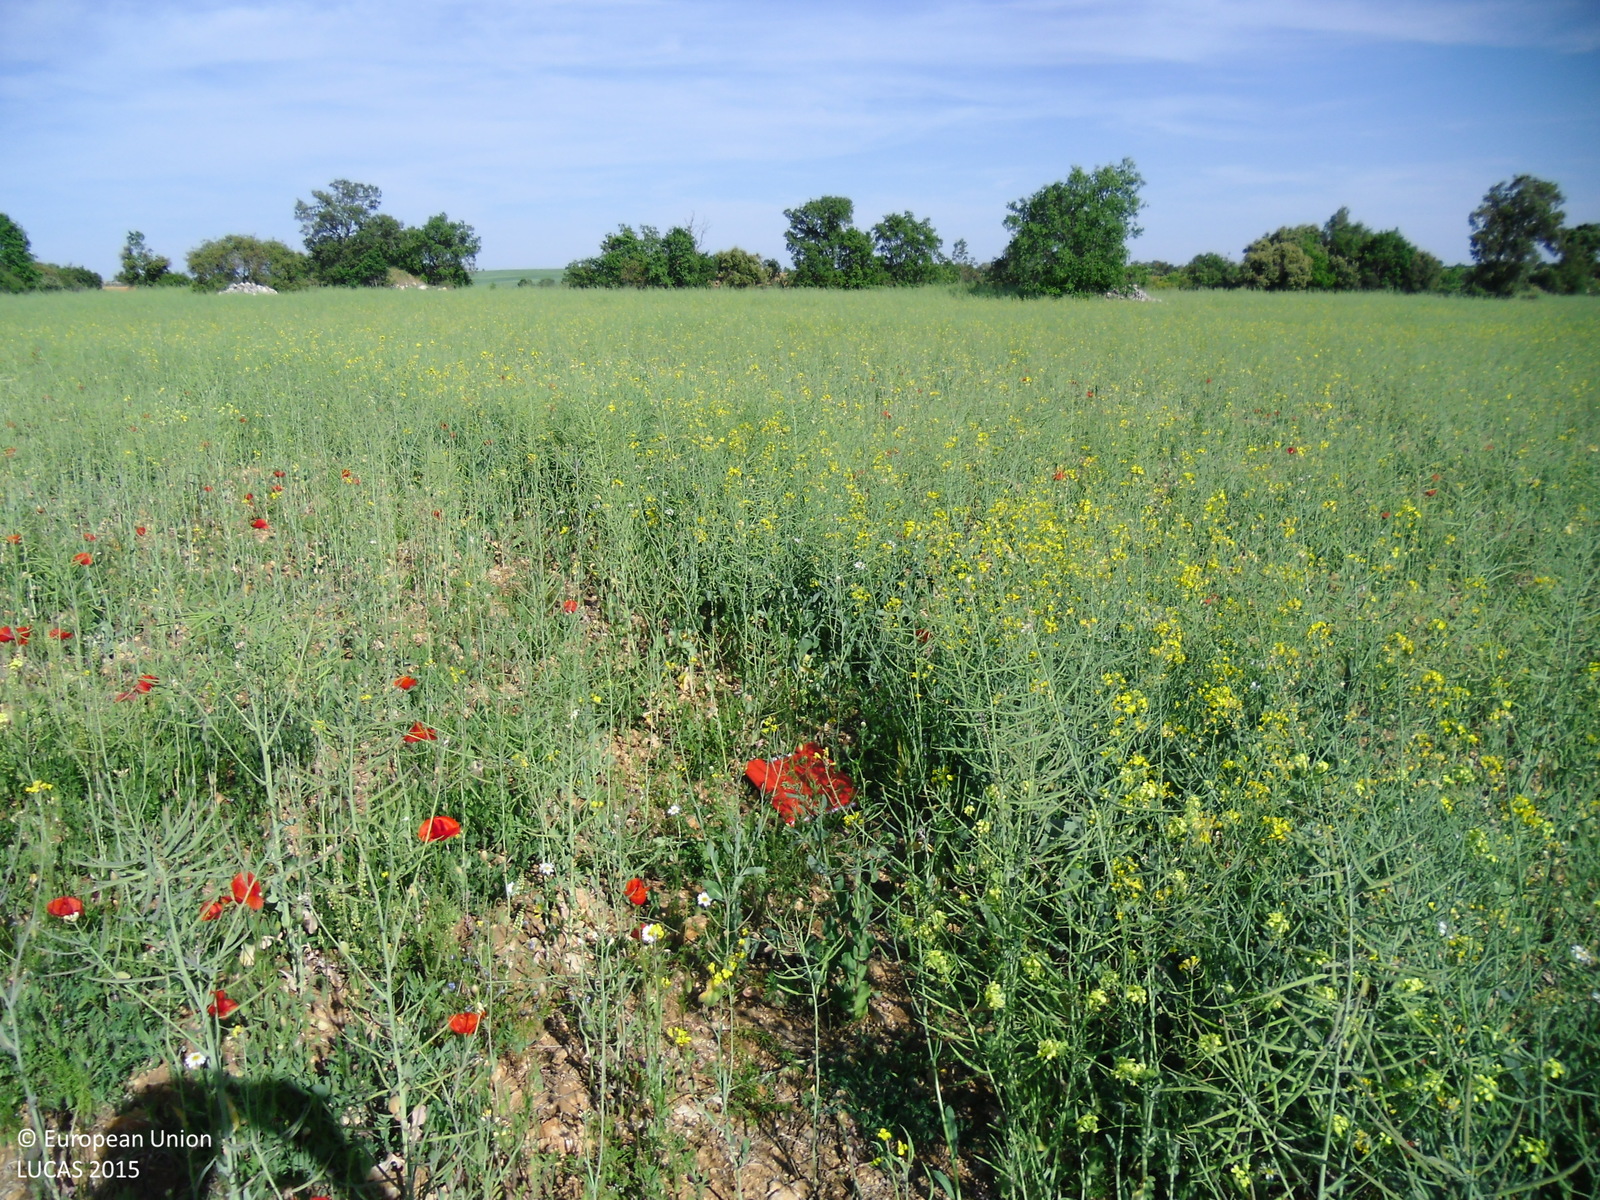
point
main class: Cropland
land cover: Rape and turnip rape
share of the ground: > 75 %
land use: Agriculture (excluding fallow land and kitchen gardens)
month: May
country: ES
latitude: 40.5445
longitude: -2.9114
